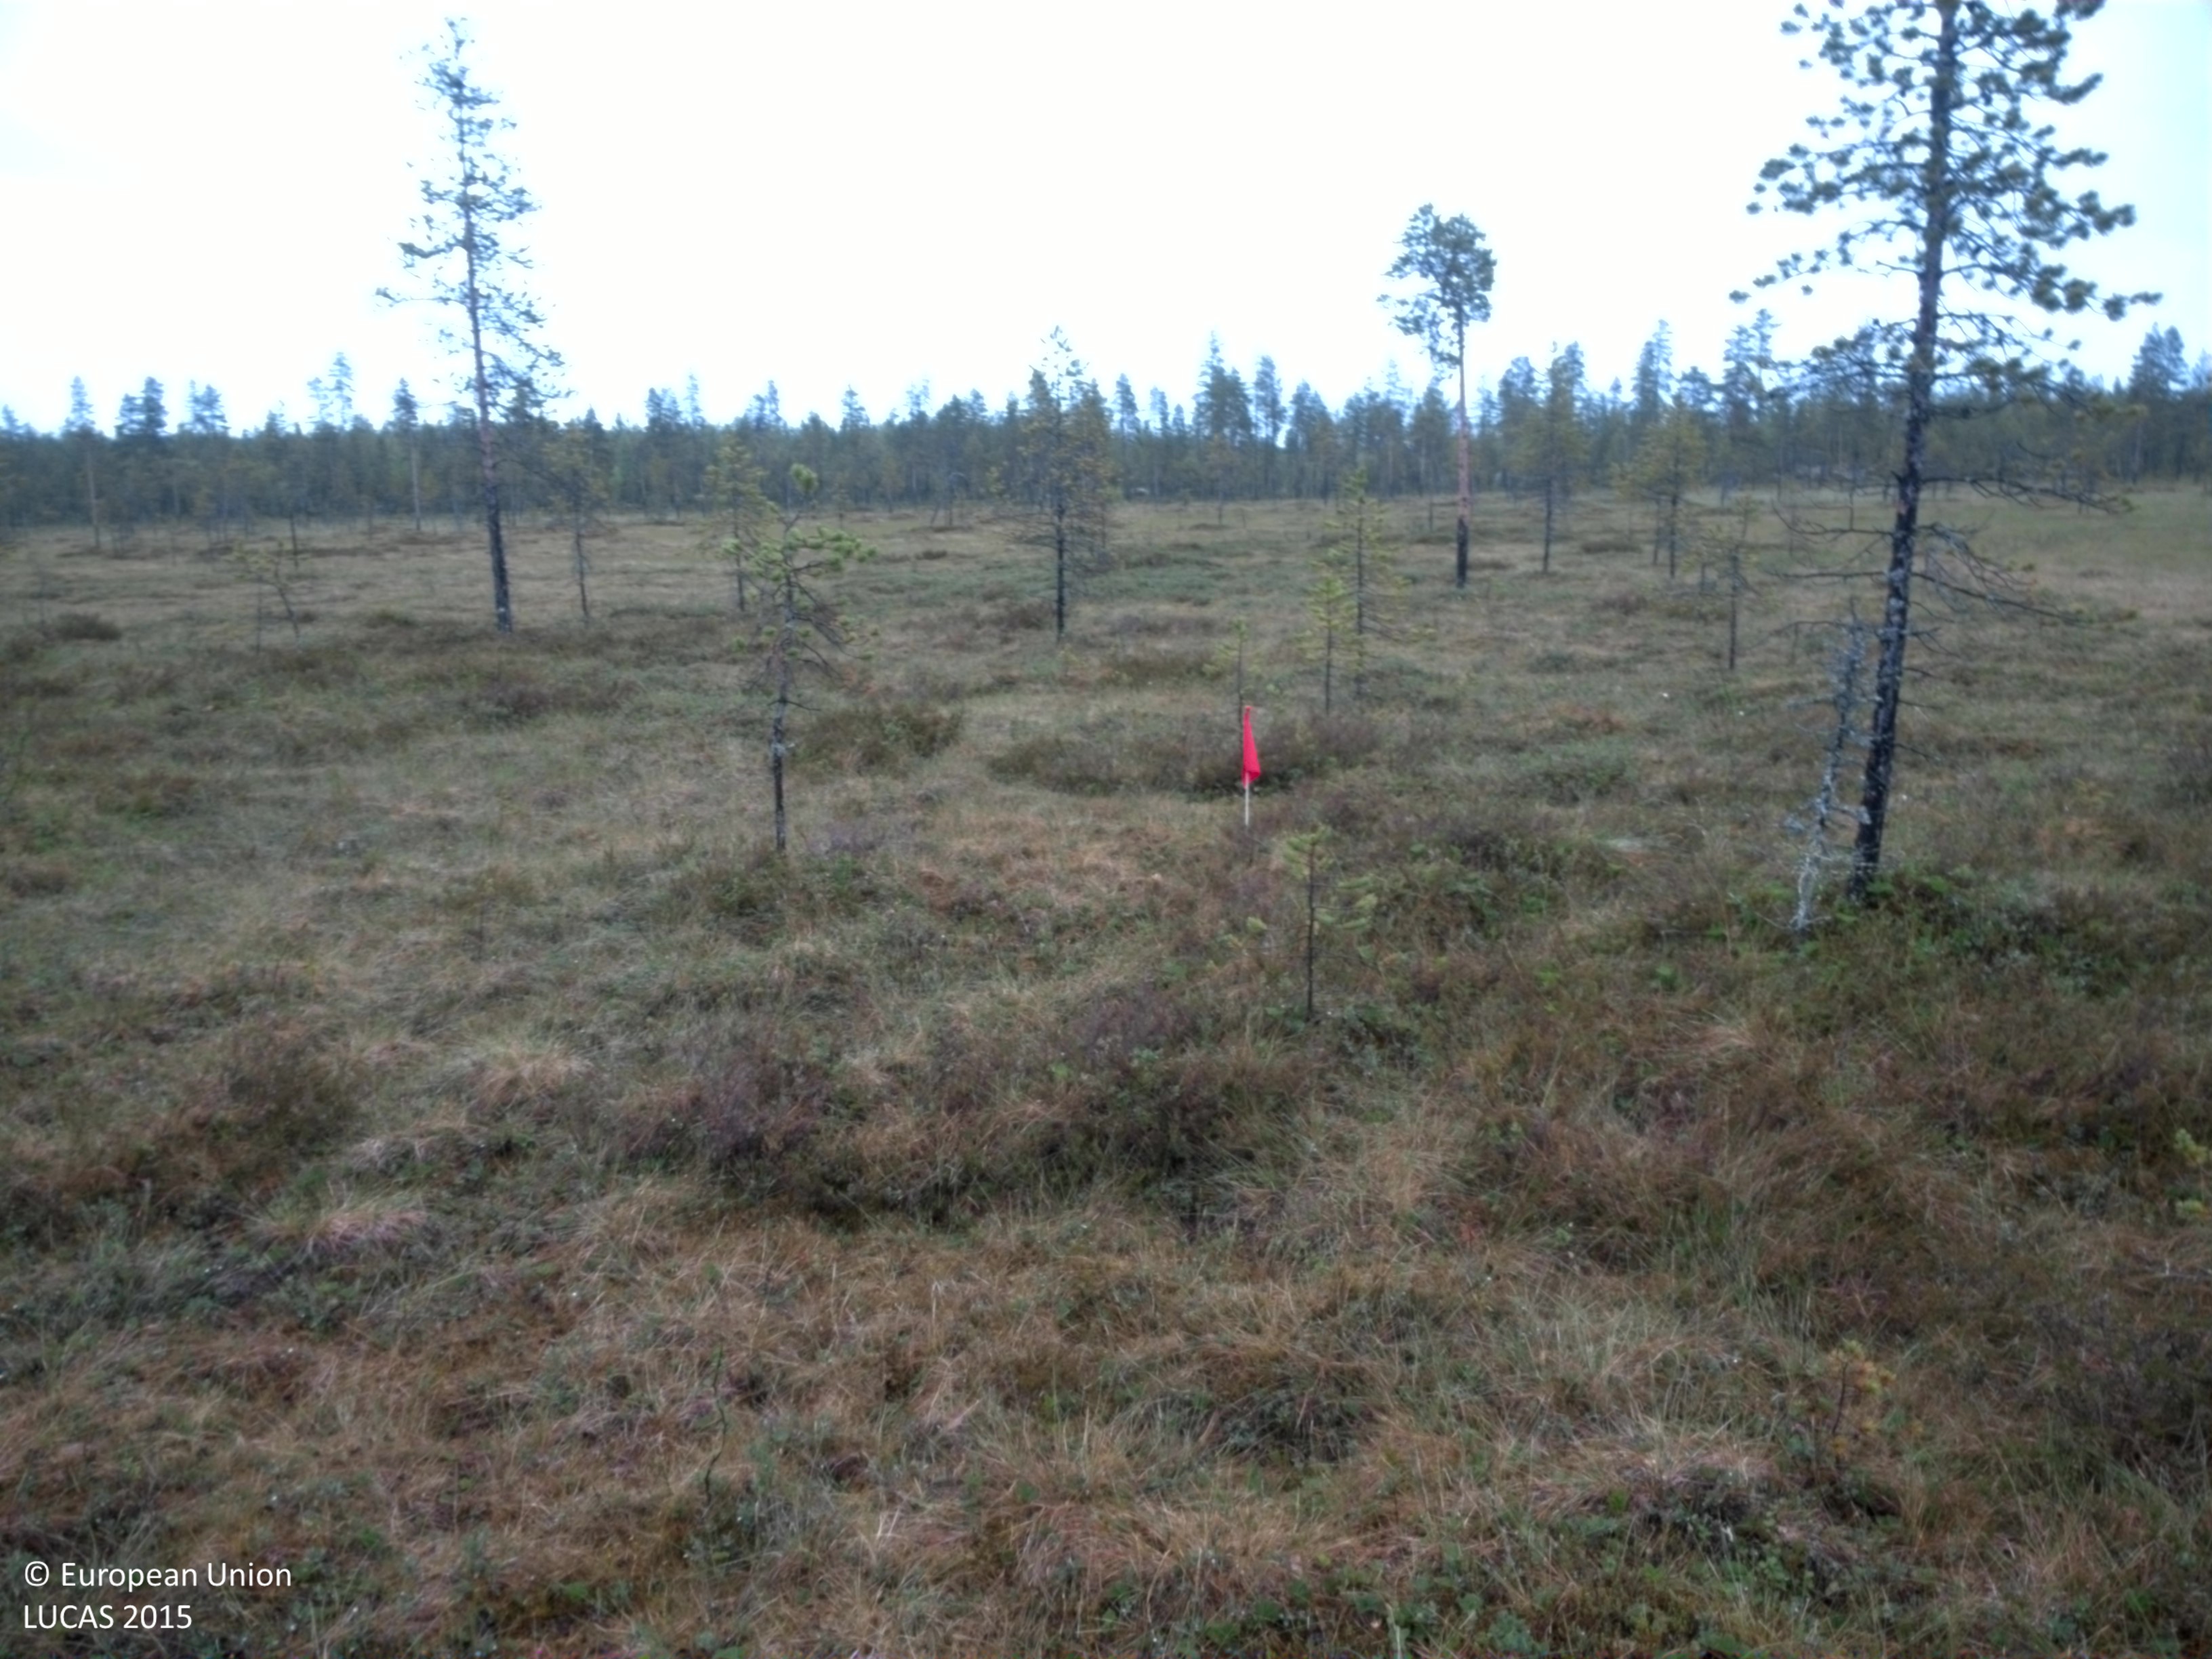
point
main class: Woodland
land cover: Pine dominated coniferous woodland
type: mire and swamp forests
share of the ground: 25 - 50 %
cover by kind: coniferous forest trees 40 %, herbaceous plants 30 %, shrubs 25 %, lichens and mosses 5 %
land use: Forestry
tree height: > 5 m
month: July
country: SE
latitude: 64.6050
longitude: 18.1801
